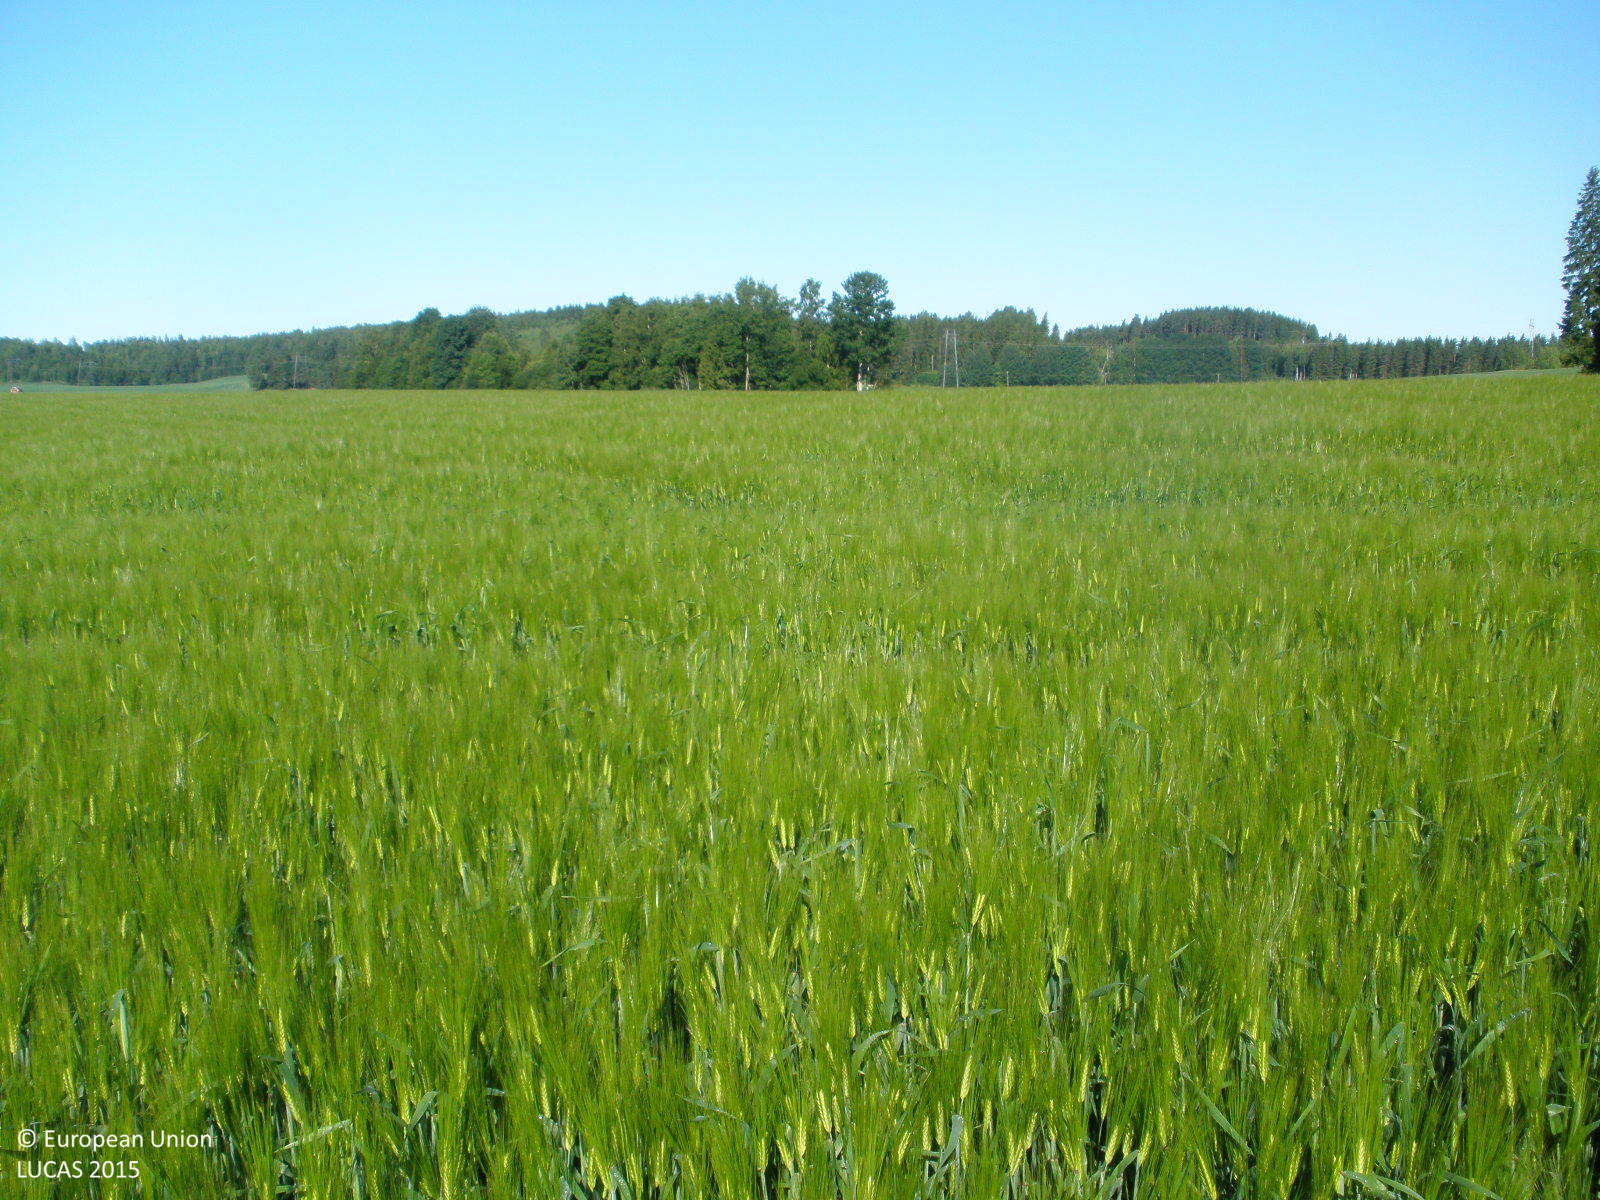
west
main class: Cropland
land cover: Barley
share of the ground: > 75 %
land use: Agriculture (excluding fallow land and kitchen gardens)
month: July
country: FI
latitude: 61.0100
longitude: 25.1548
